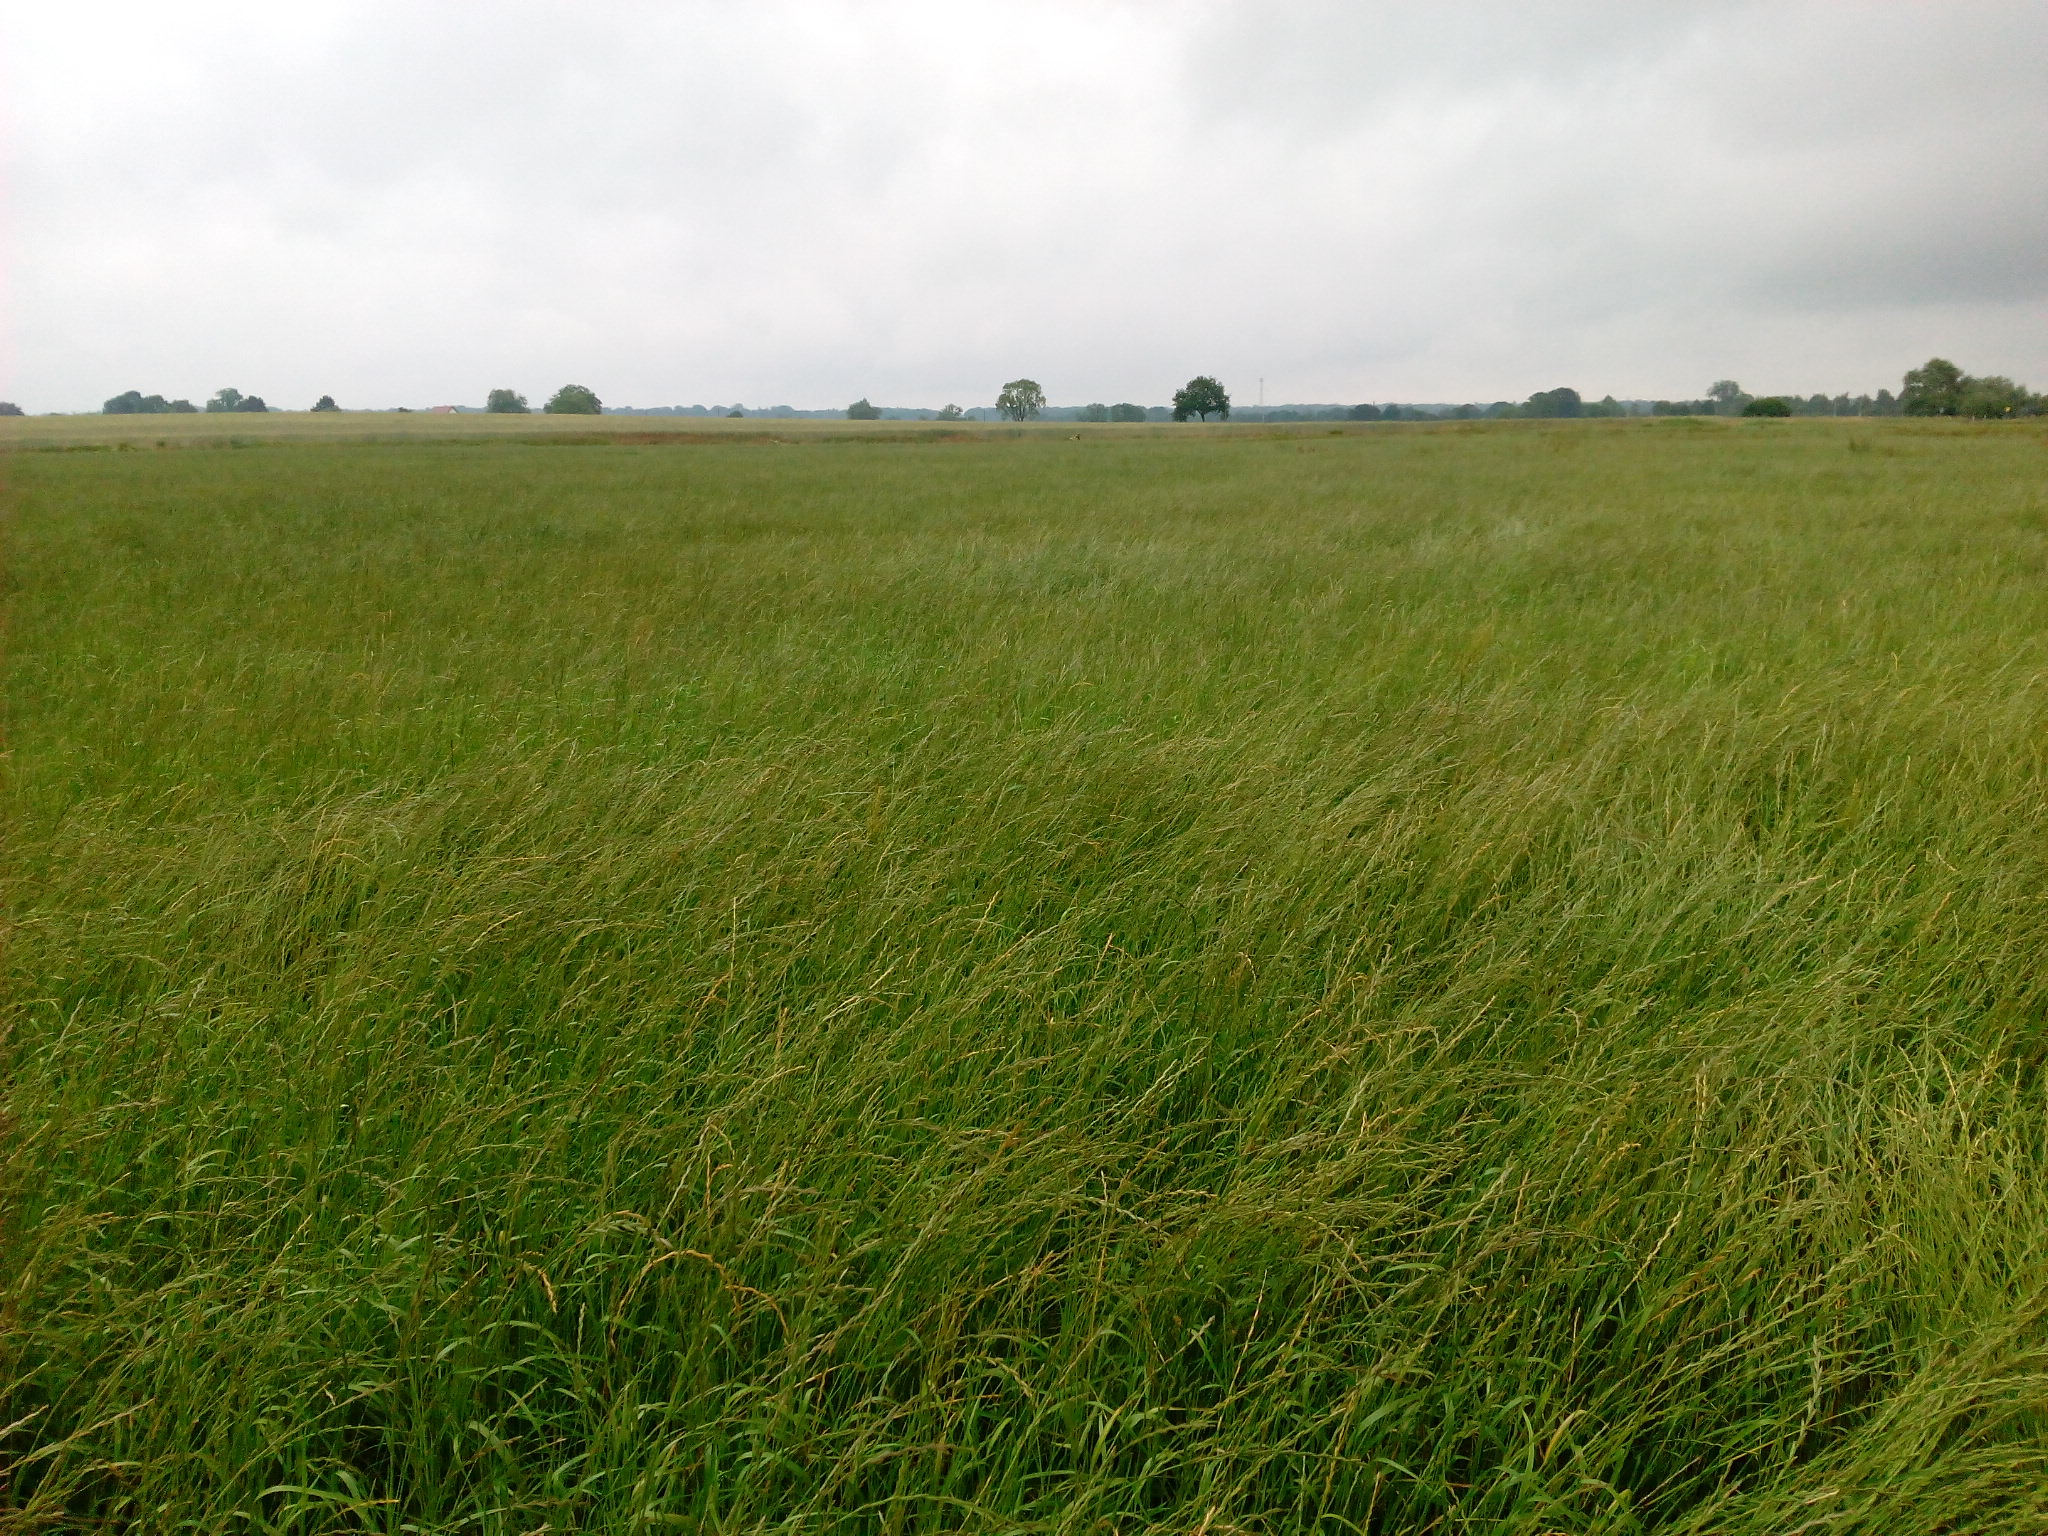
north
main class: Cropland
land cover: Temporary grasslands
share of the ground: > 75 %
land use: Agriculture (excluding fallow land and kitchen gardens)
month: June
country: DE
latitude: 53.0365
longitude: 13.1763
